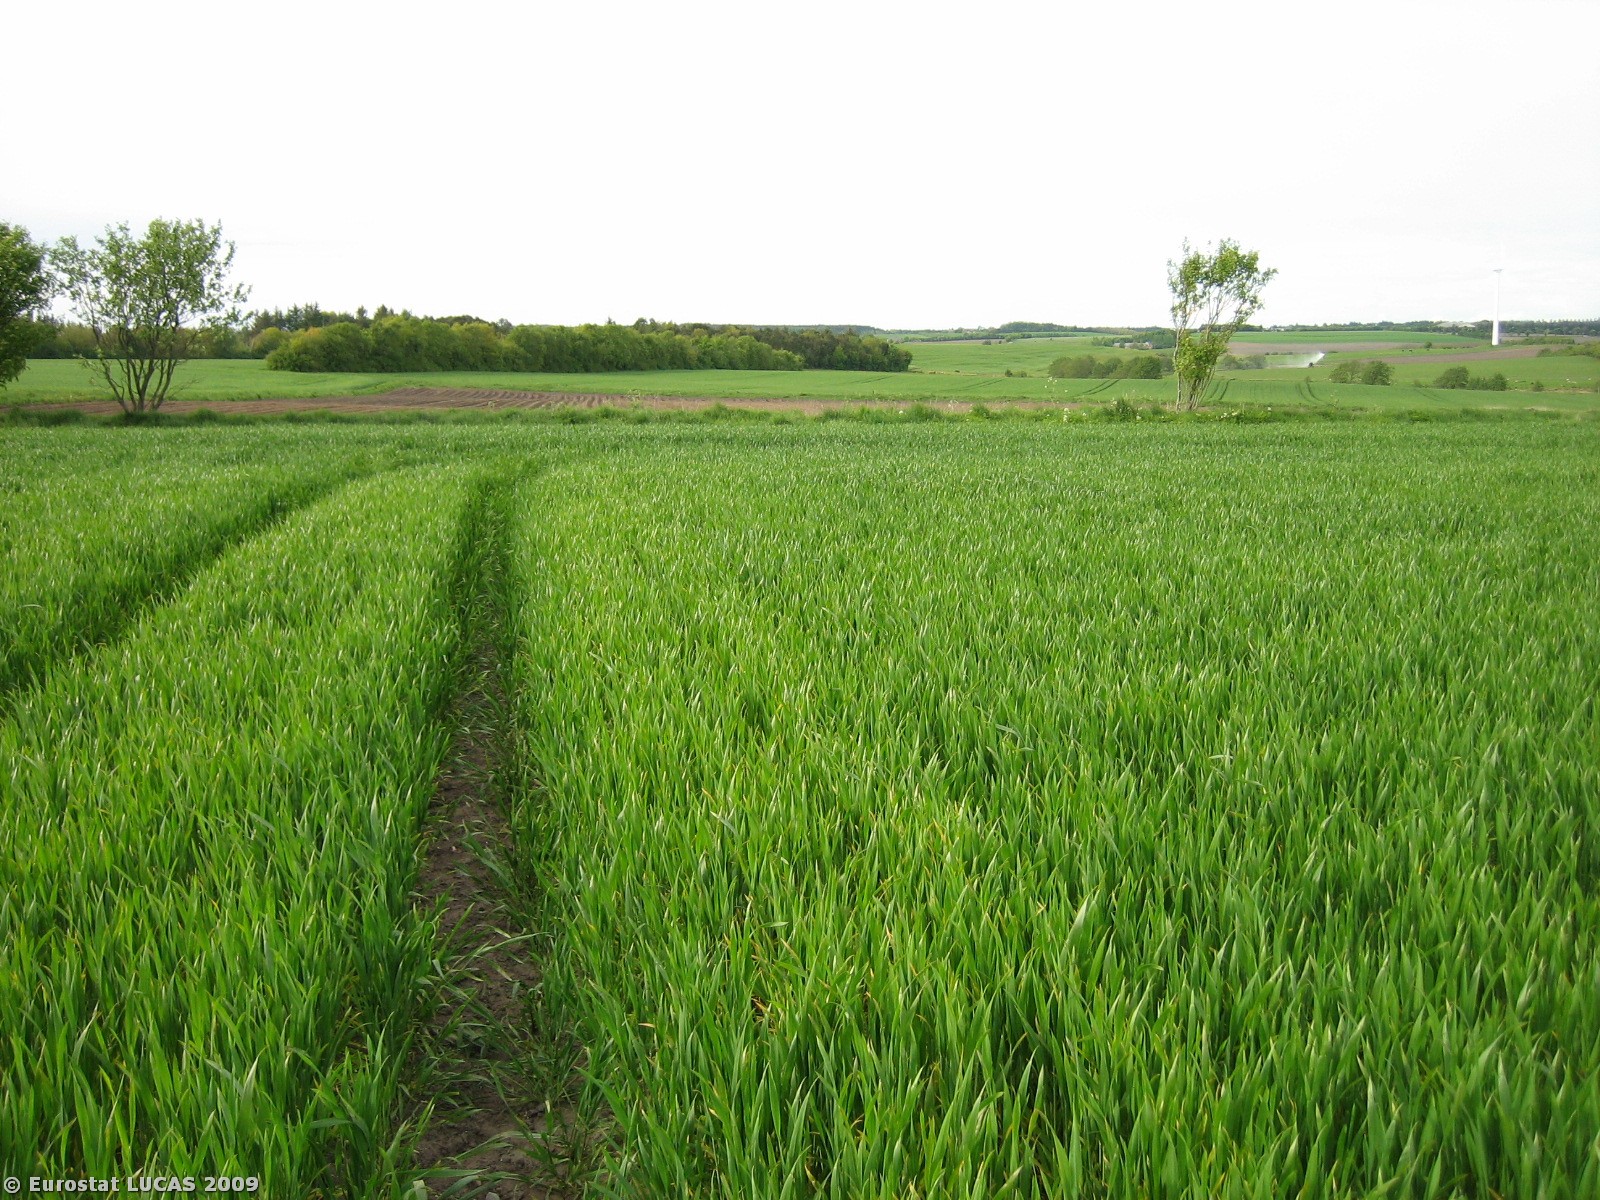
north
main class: Cropland
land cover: Common wheat
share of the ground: > 75 %
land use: Agriculture (excluding fallow land and kitchen gardens)
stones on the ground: < 10 %
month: May
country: DK
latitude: 56.1247
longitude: 8.4734
